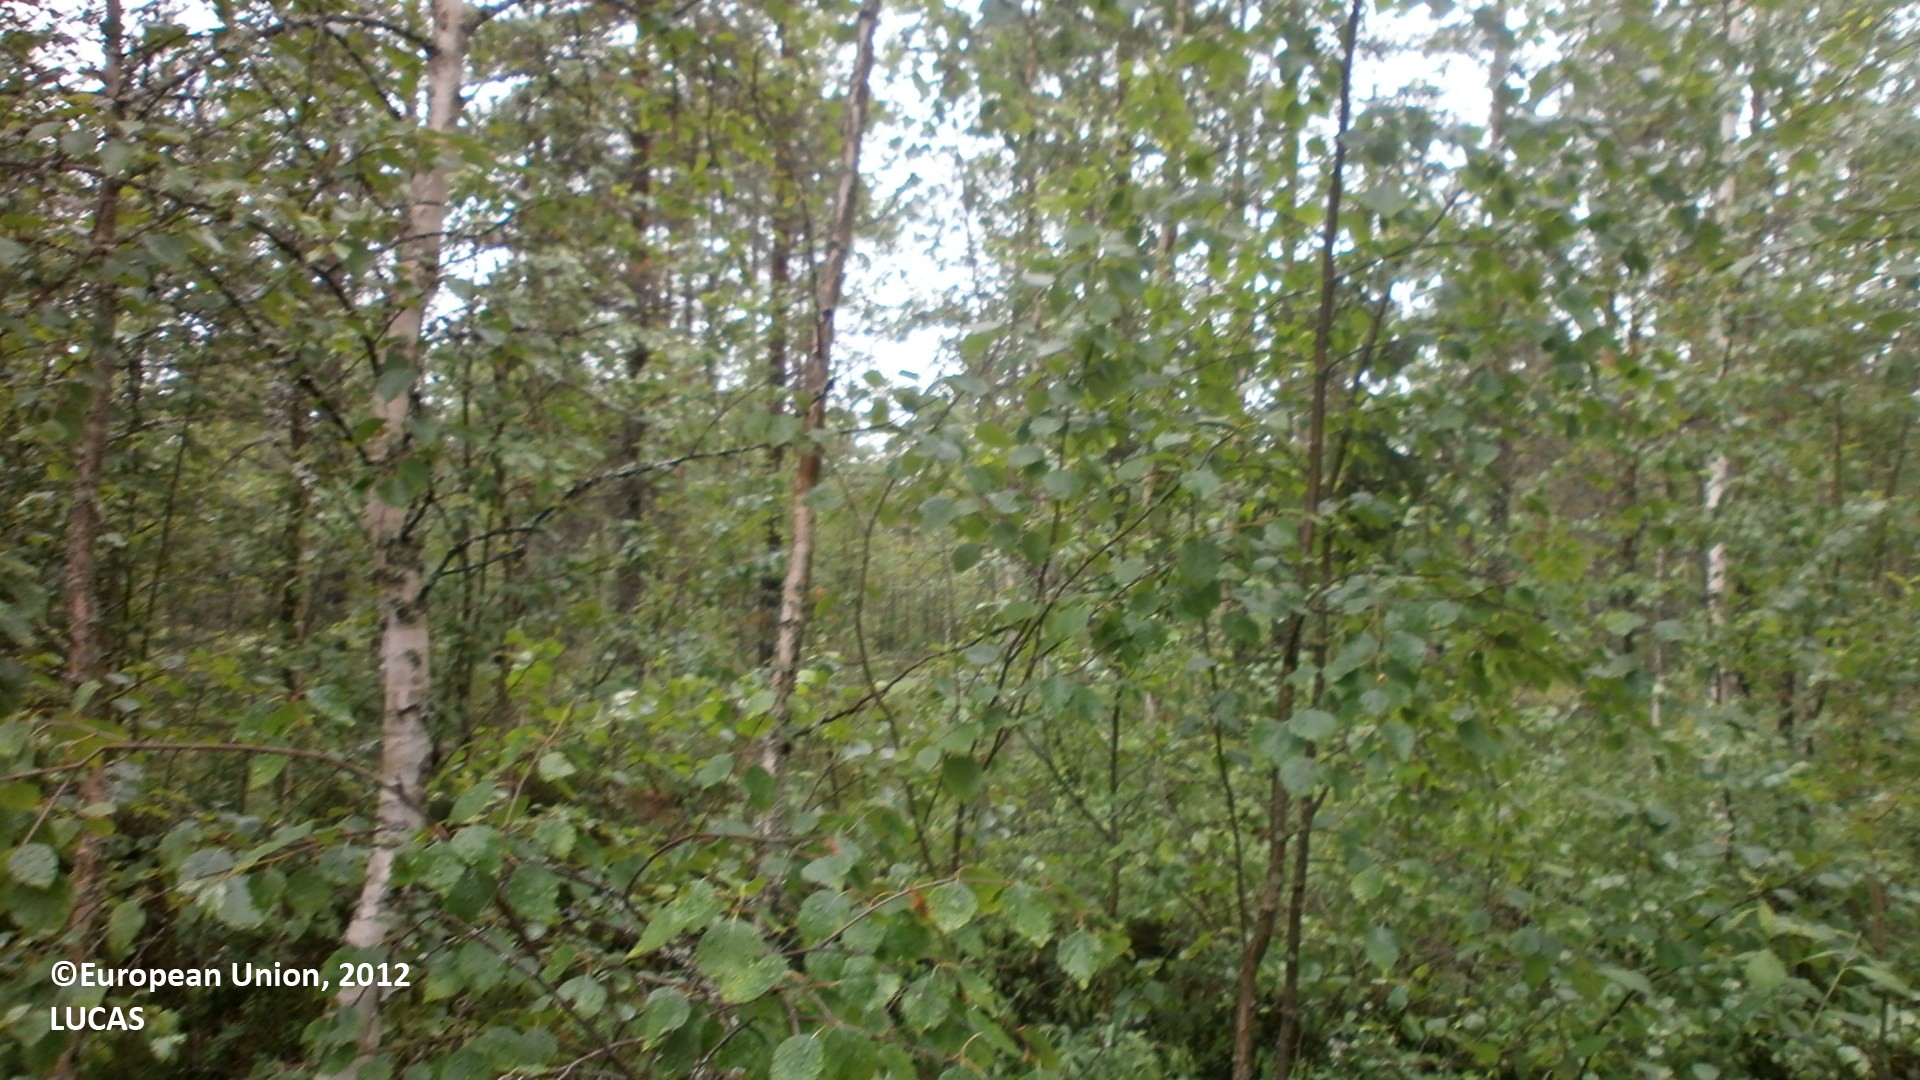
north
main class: Woodland
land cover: Pine dominated mixed woodland
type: boreal forest
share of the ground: 50 - 75 %
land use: Forestry
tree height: > 5 m
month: July
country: FI
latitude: 64.3862
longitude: 24.9443
